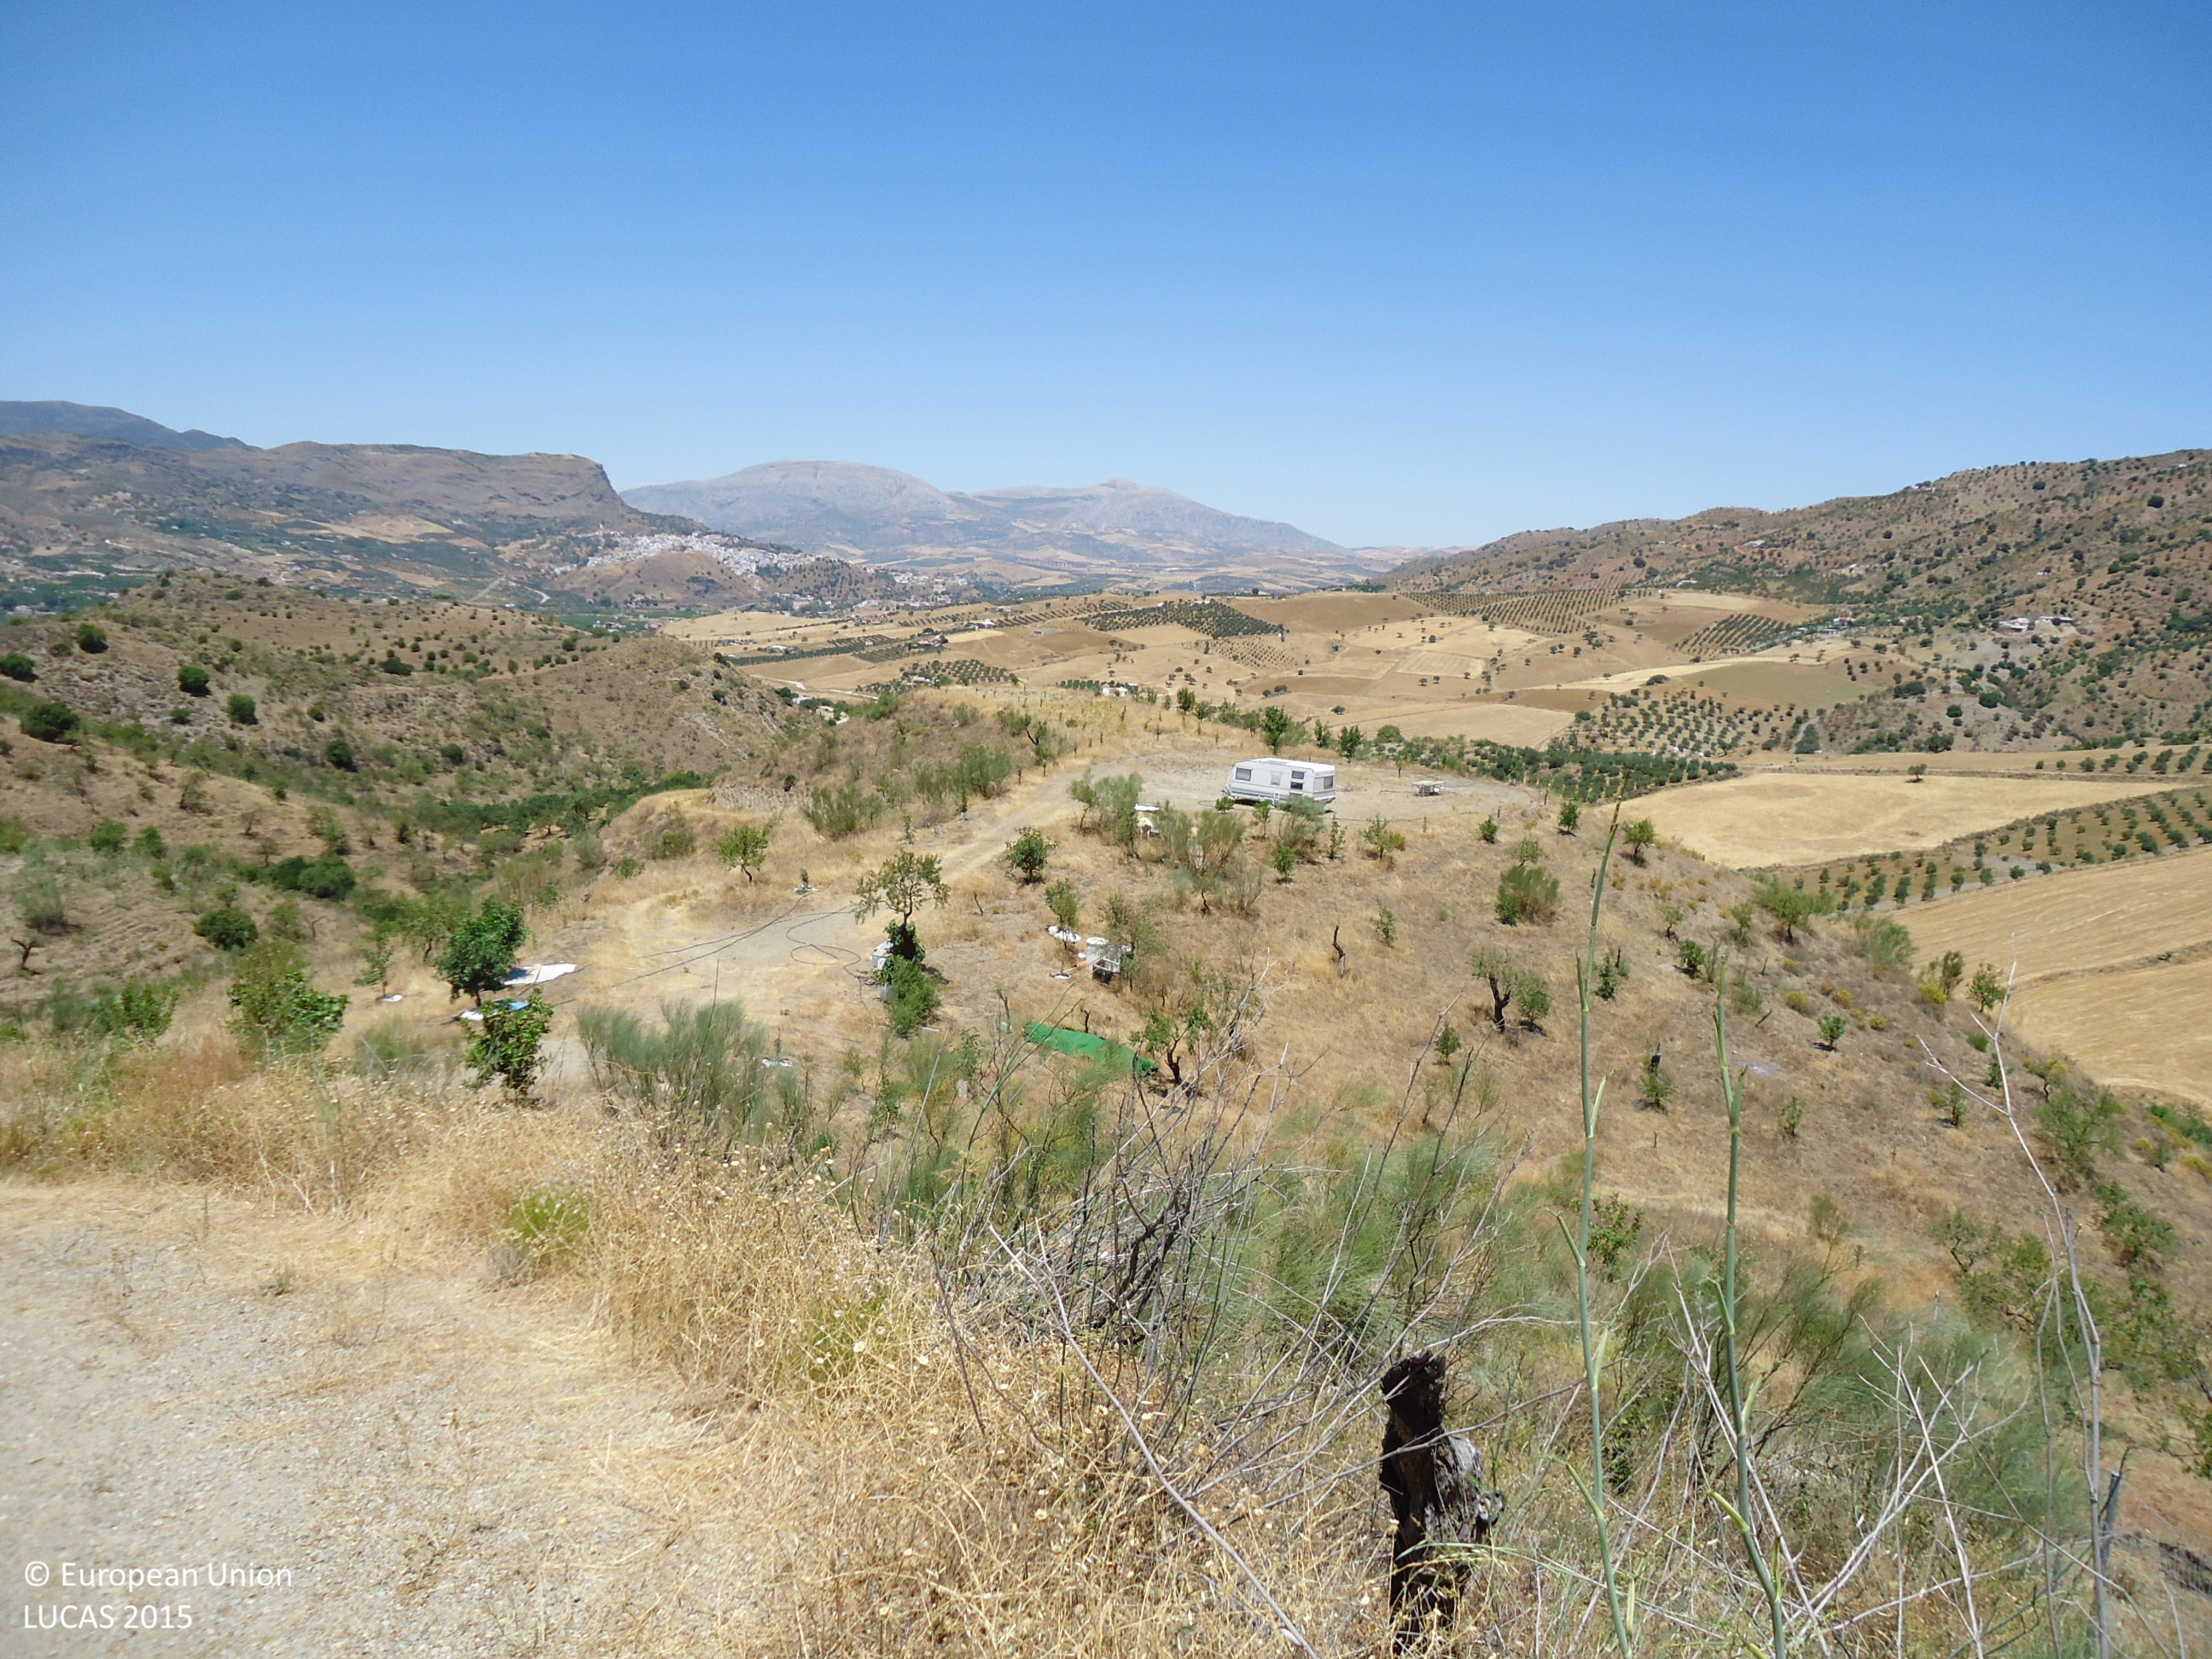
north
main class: Cropland
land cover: Nuts trees
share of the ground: 25 - 50 %
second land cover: Other bare soil
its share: > 75 %
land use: Agriculture (excluding fallow land and kitchen gardens)
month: June
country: ES
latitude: 36.7848
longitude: -4.6844
